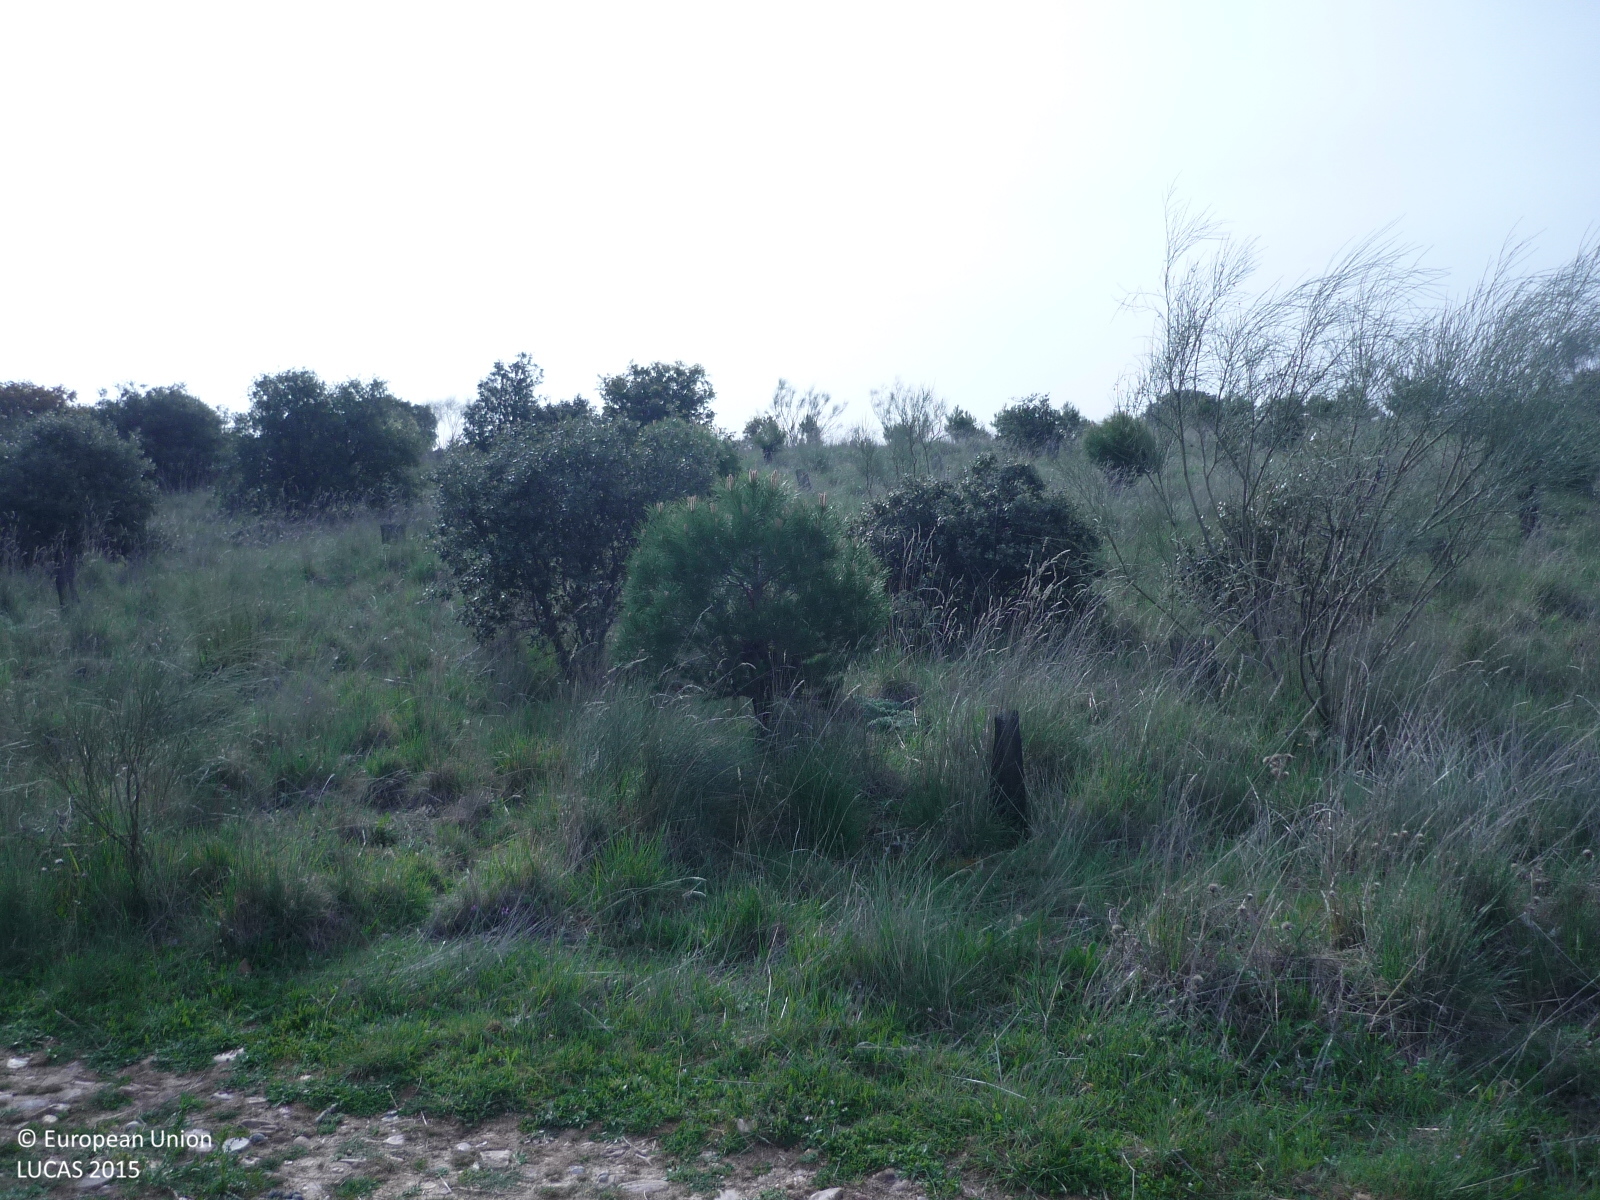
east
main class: Woodland
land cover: Broadleaved woodland
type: broadleaved evergreen forest
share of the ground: 50 - 75 %
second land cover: Grassland without tree/shrub cover
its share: > 75 %
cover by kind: broadleaved forest trees 60 %, herbaceous plants 25 %, unconsolidated bare surface 10 %, shrubs 5 %
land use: Forestry
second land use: Agriculture (excluding fallow land and kitchen gardens)
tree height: < 5 m
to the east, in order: Broadleaved woodland; Grassland without tree/shrub cover; Tracks; Broadleaved woodland; Fences; Broadleaved woodland; Tracks; Grassland with sparse tree/shrub cover; Tracks; Shrubland with sparse tree cover
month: April
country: ES
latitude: 40.6597
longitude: -3.4142
